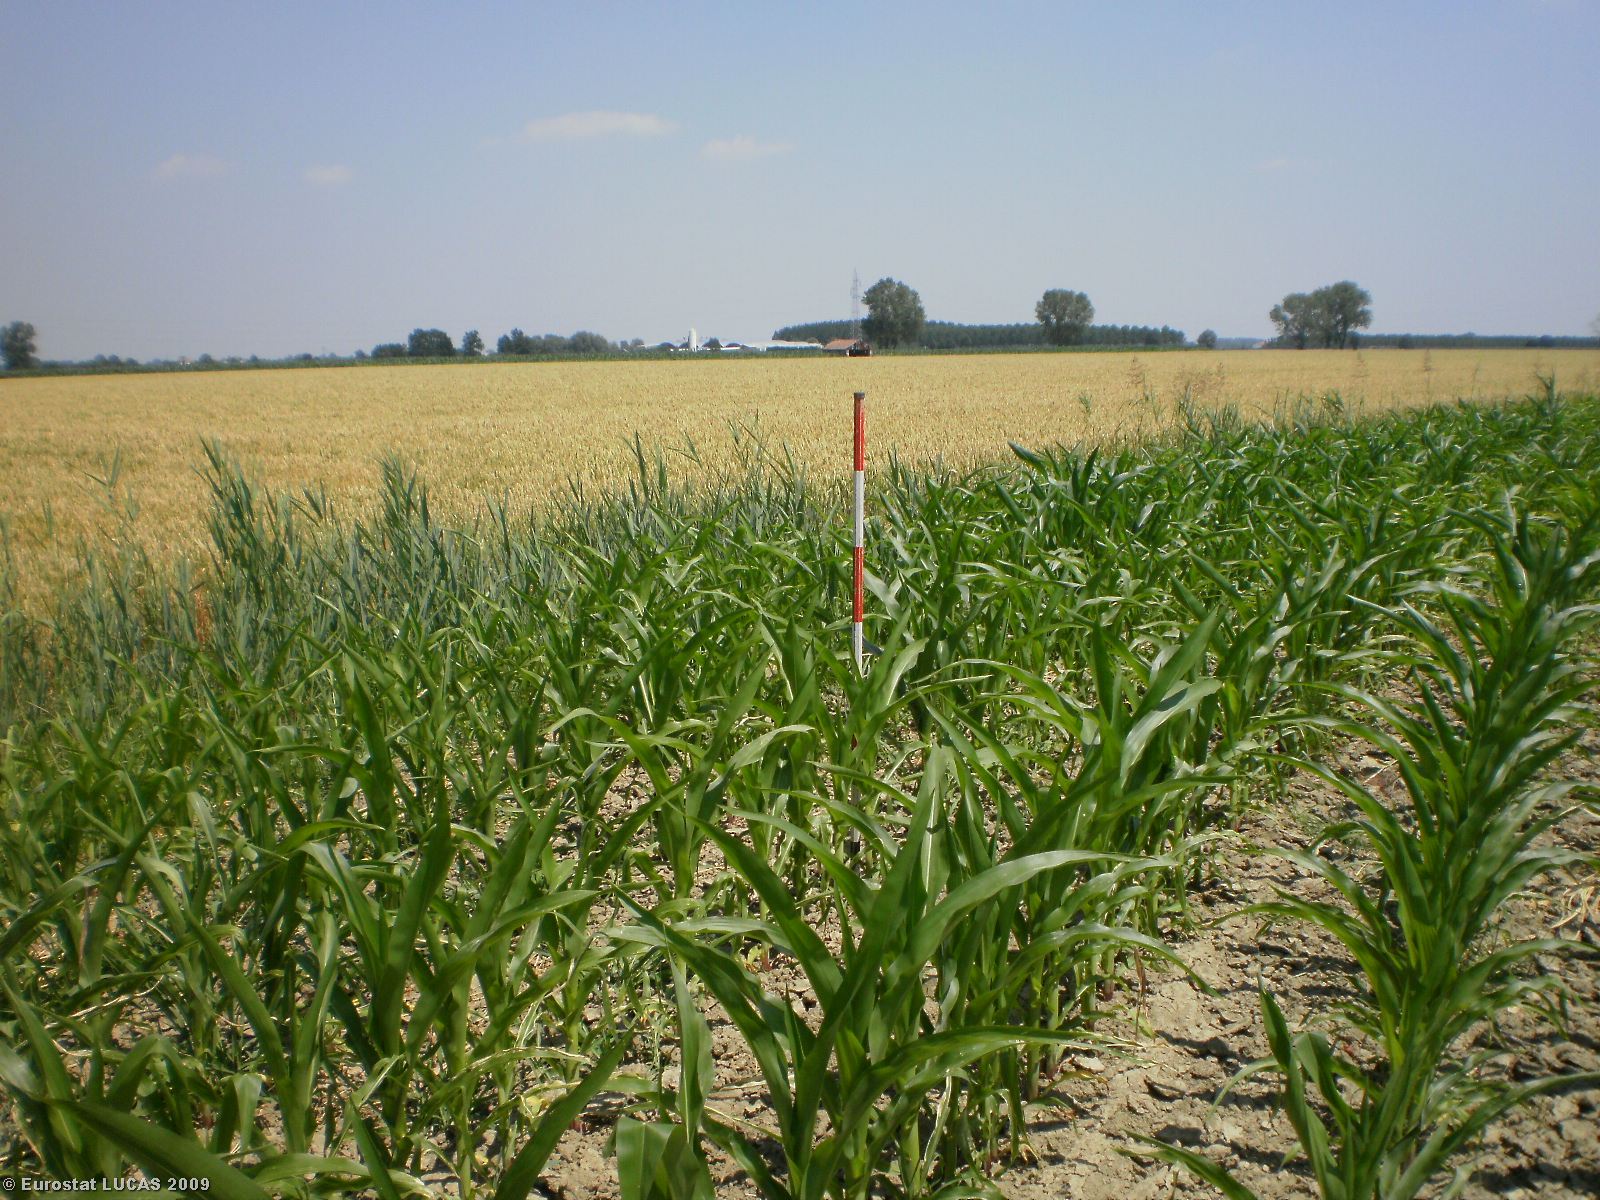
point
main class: Woodland
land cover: Broadleaved woodland
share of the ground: > 75 %
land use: Unused
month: June
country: IT
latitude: 45.0352
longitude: 10.3421
